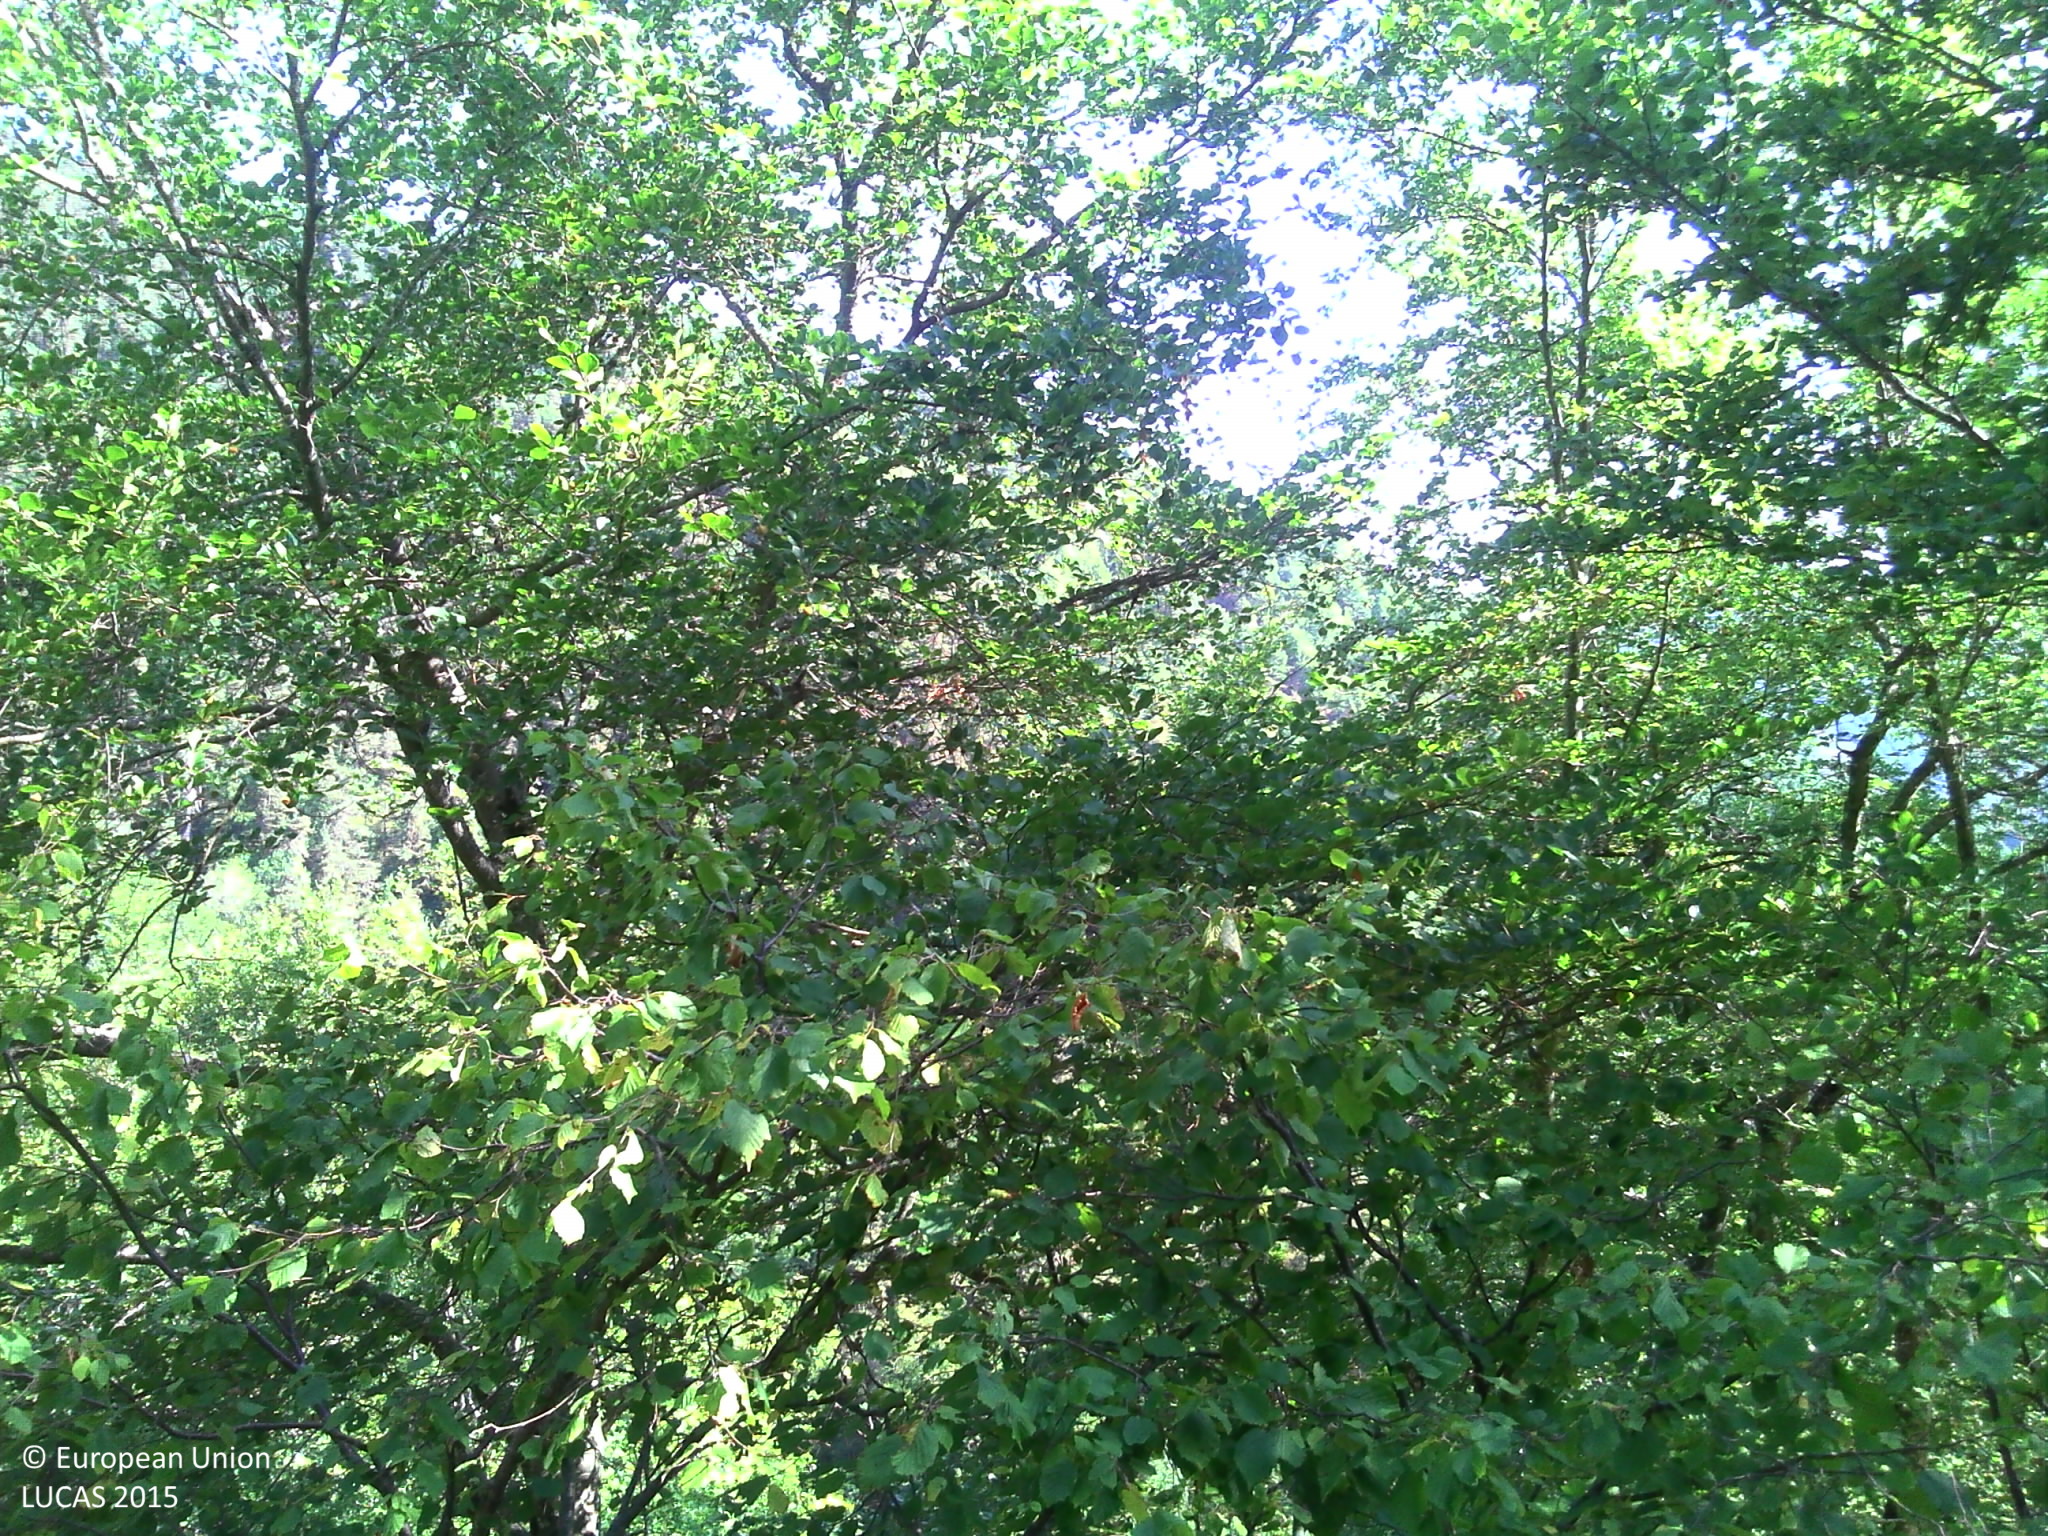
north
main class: Woodland
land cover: Broadleaved woodland
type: acidophilous oak and oak-birch forest
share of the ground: > 75 %
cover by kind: broadleaved forest trees 80 %, coniferous forest trees 10 %, shrubs 10 %
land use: Forestry
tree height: > 5 m
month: August
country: FR
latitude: 45.2168
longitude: 3.8530
